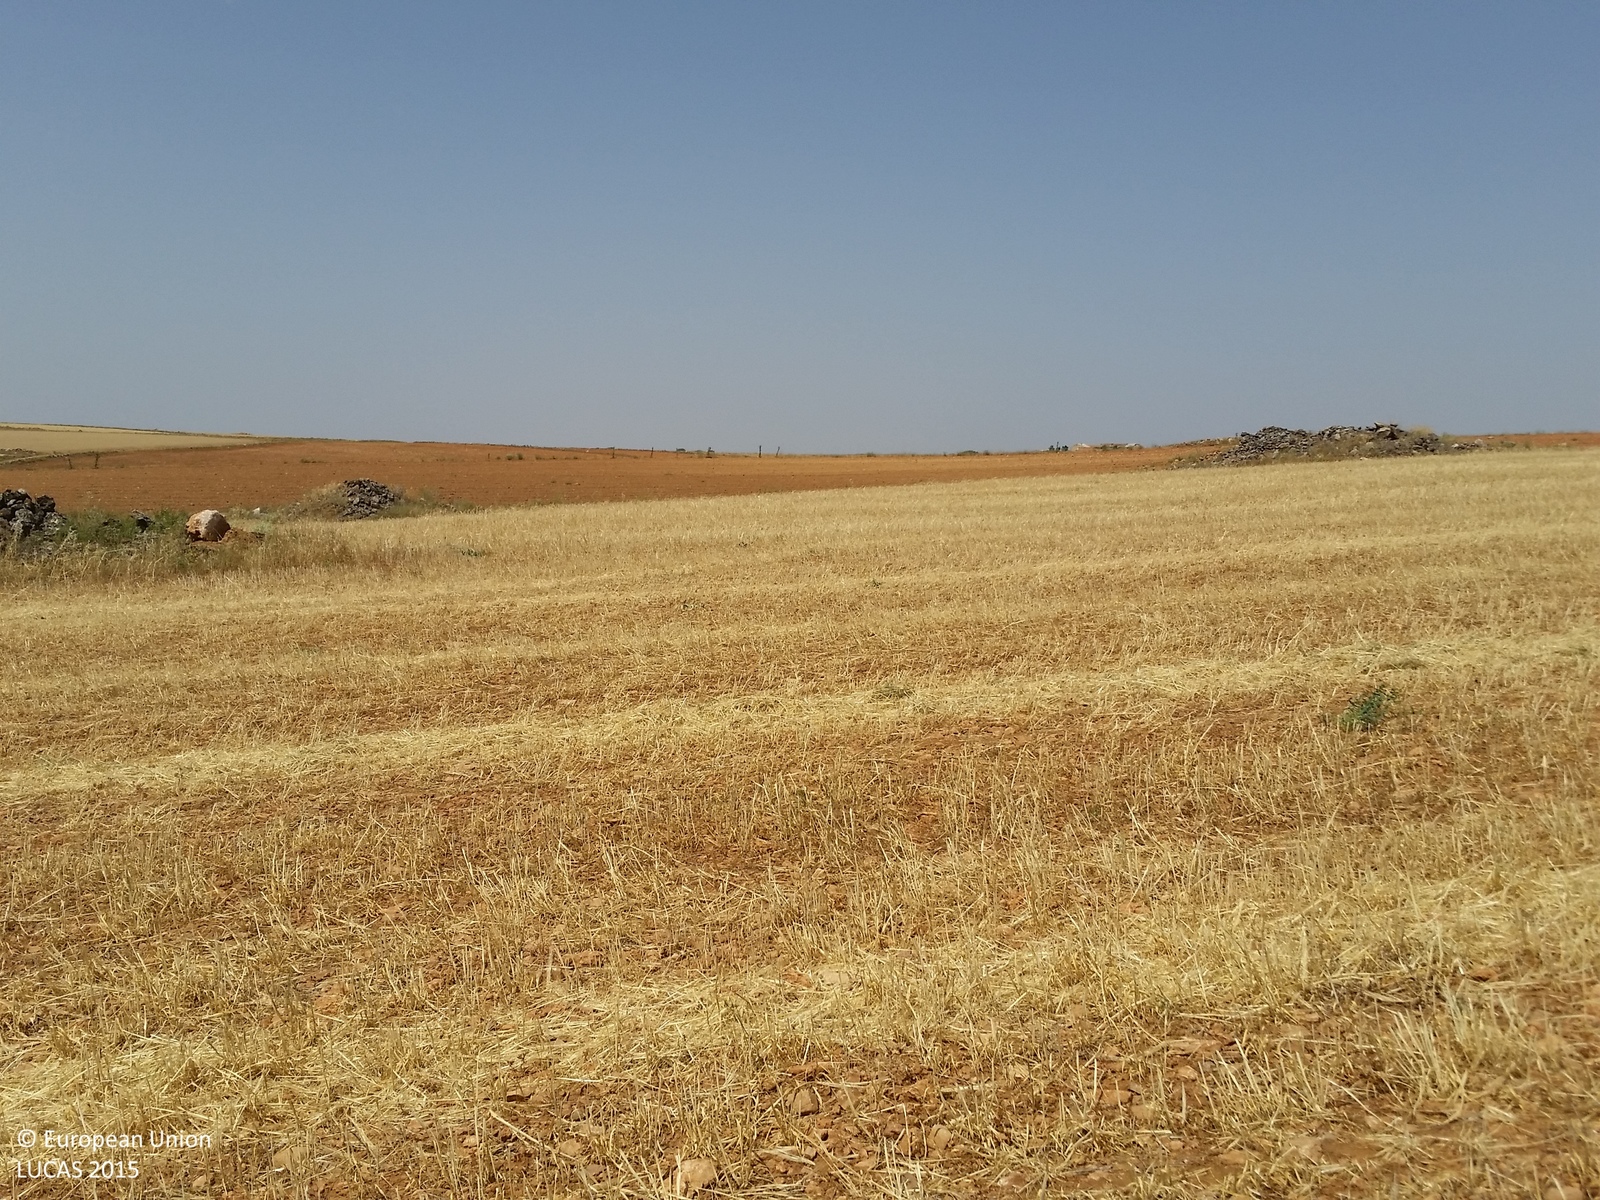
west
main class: Cropland
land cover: Barley
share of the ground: < 10 %
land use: Agriculture (excluding fallow land and kitchen gardens)
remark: Harvested field
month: June
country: ES
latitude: 38.8152
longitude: -2.5686
